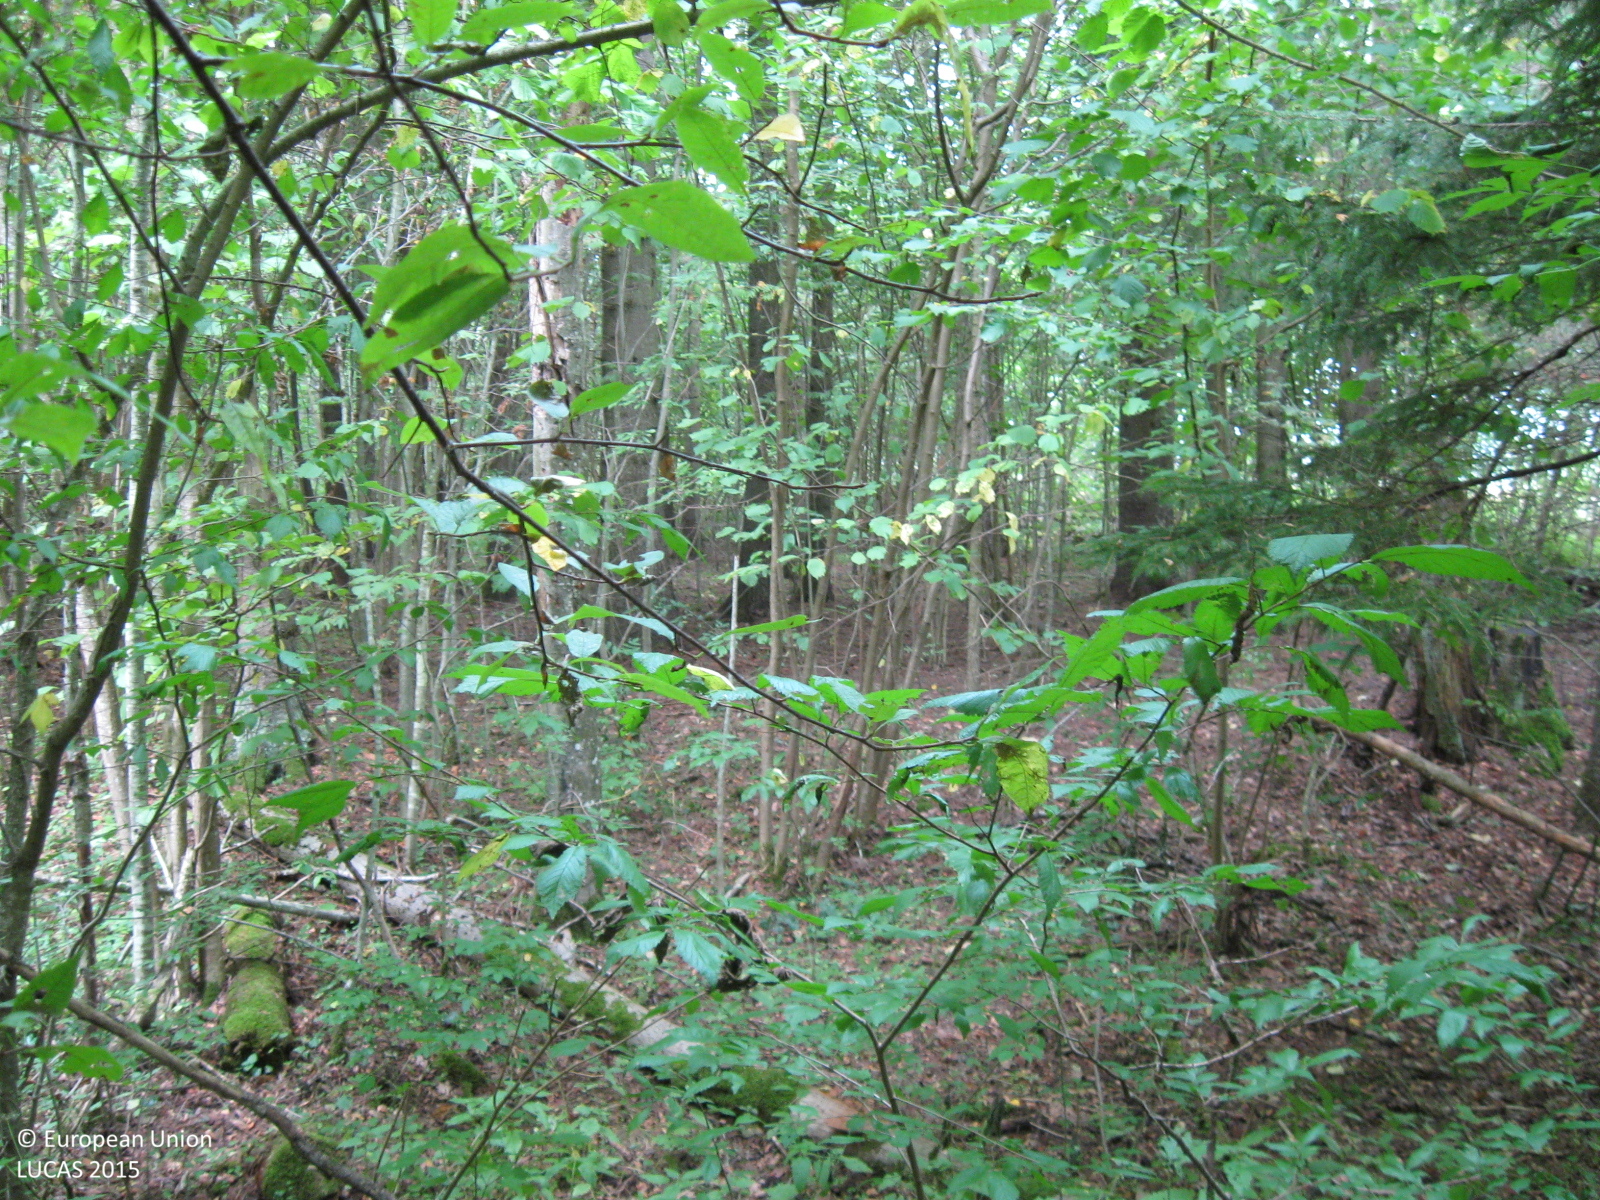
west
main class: Woodland
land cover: Other mixed woodland
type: hemiboreal forest and nemoral coniferous forest and mixed broadleaved-coniferous forest
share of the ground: > 75 %
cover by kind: broadleaved forest trees 55 %, coniferous forest trees 45 %
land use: Forestry
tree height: > 5 m
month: August
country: LT
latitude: 55.1520
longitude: 23.4011
